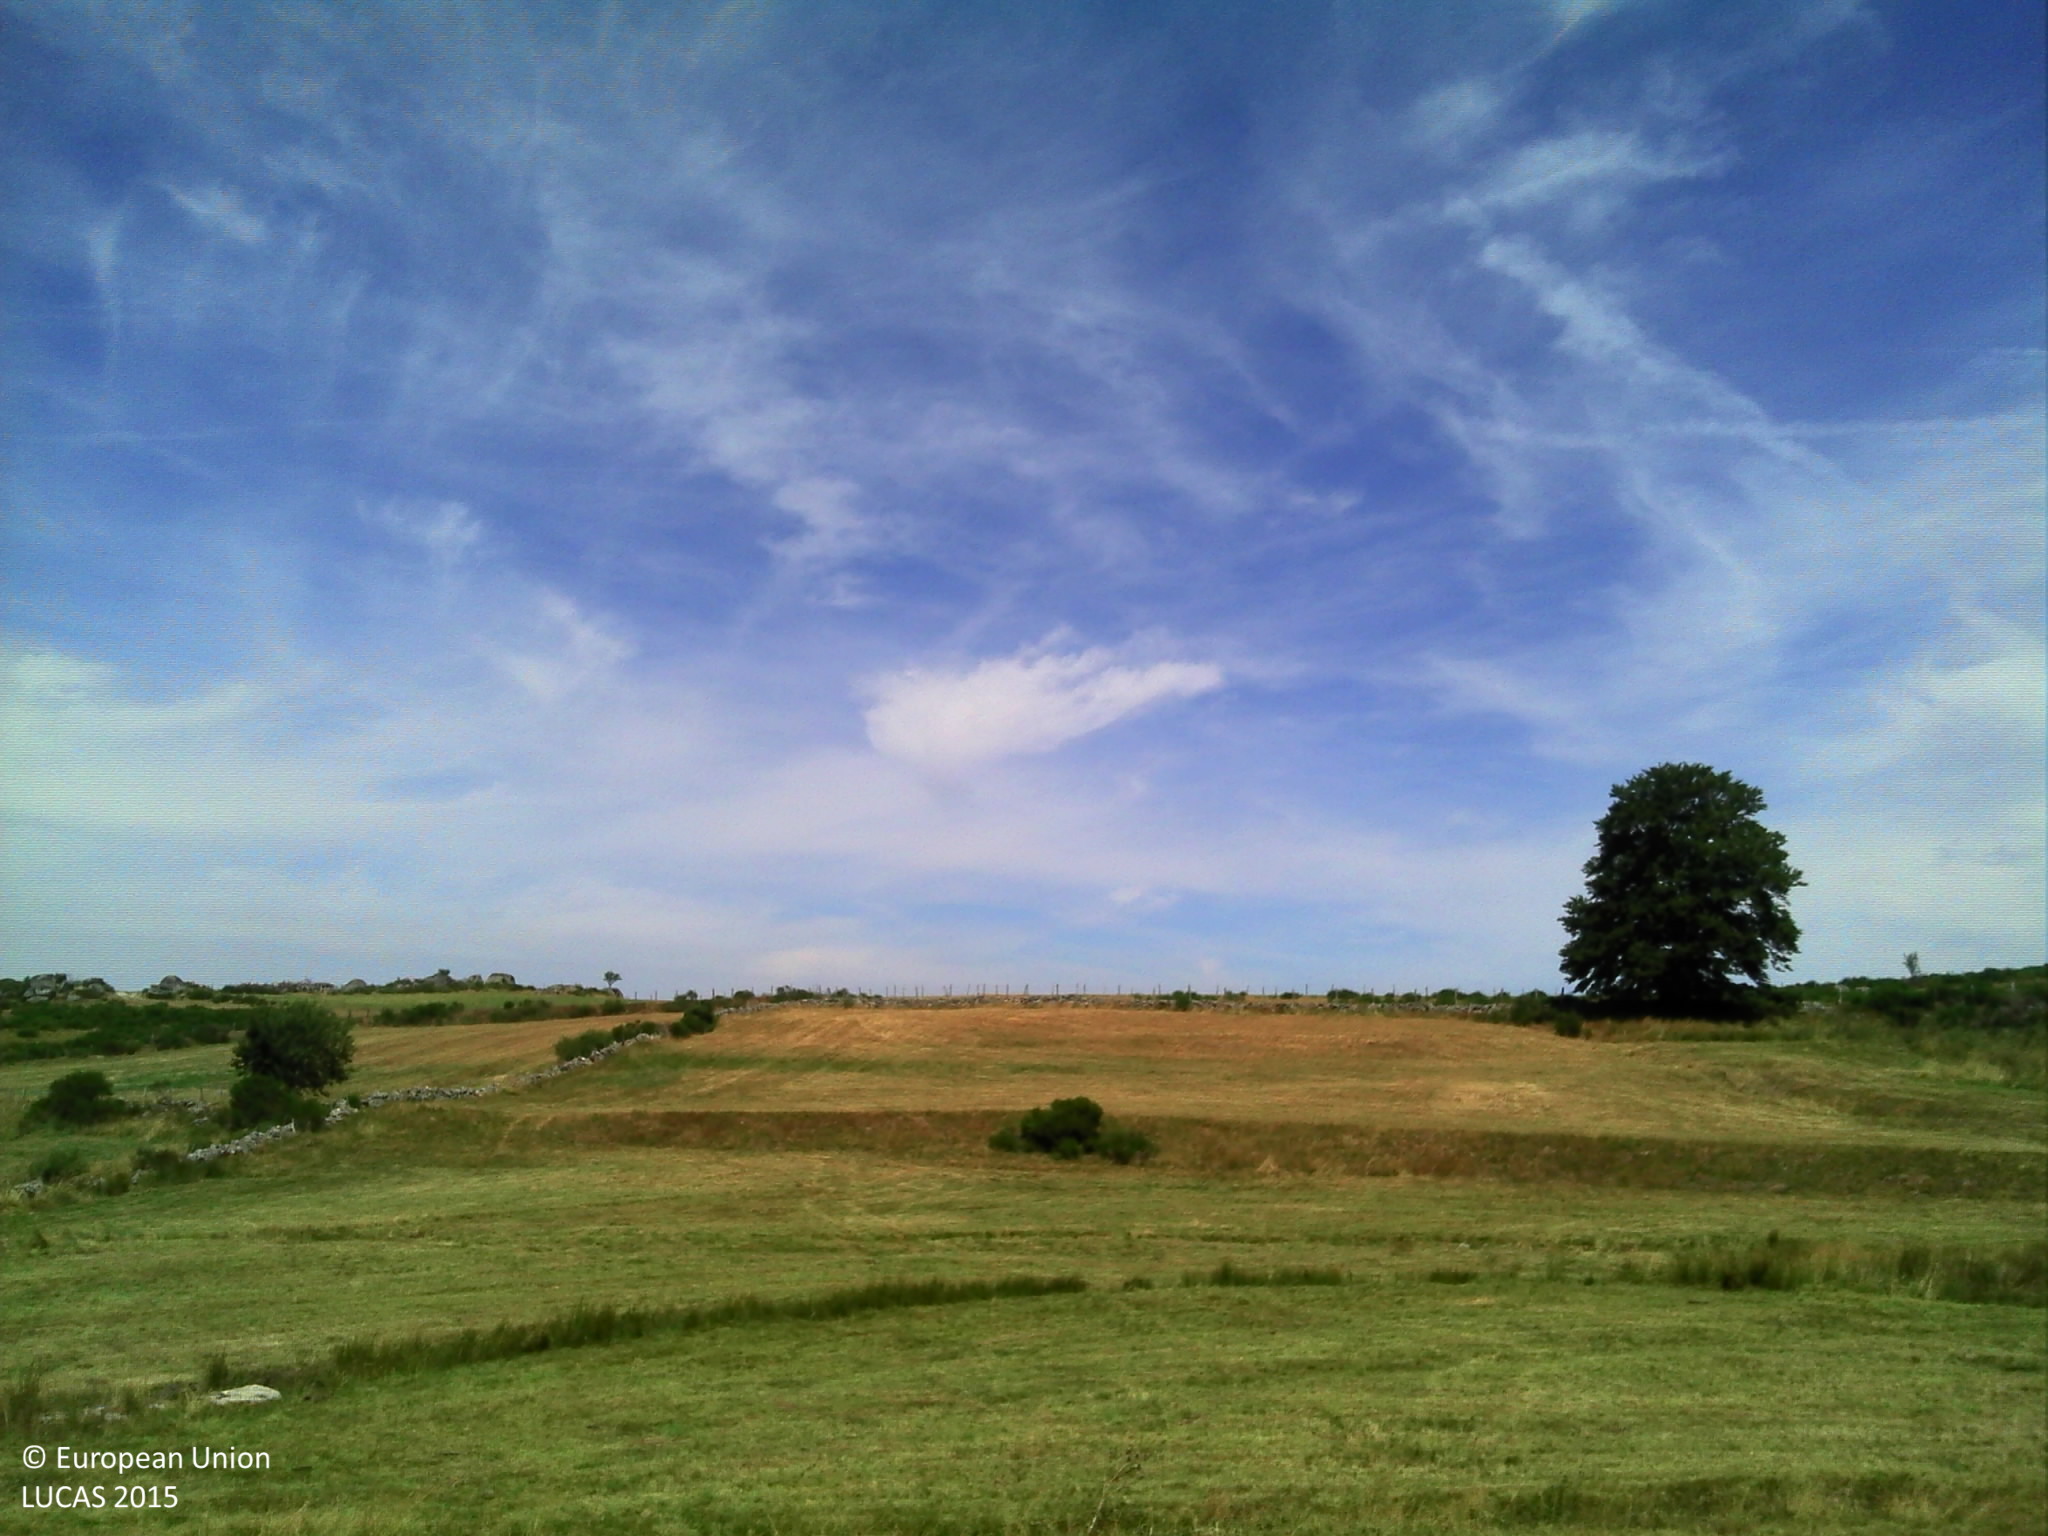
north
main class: Grassland
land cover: Grassland without tree/shrub cover
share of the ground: > 75 %
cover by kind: herbaceous plants 100 %
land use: Agriculture (excluding fallow land and kitchen gardens)
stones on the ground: 10 - 25 %
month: July
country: FR
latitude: 44.6868
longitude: 3.1778
